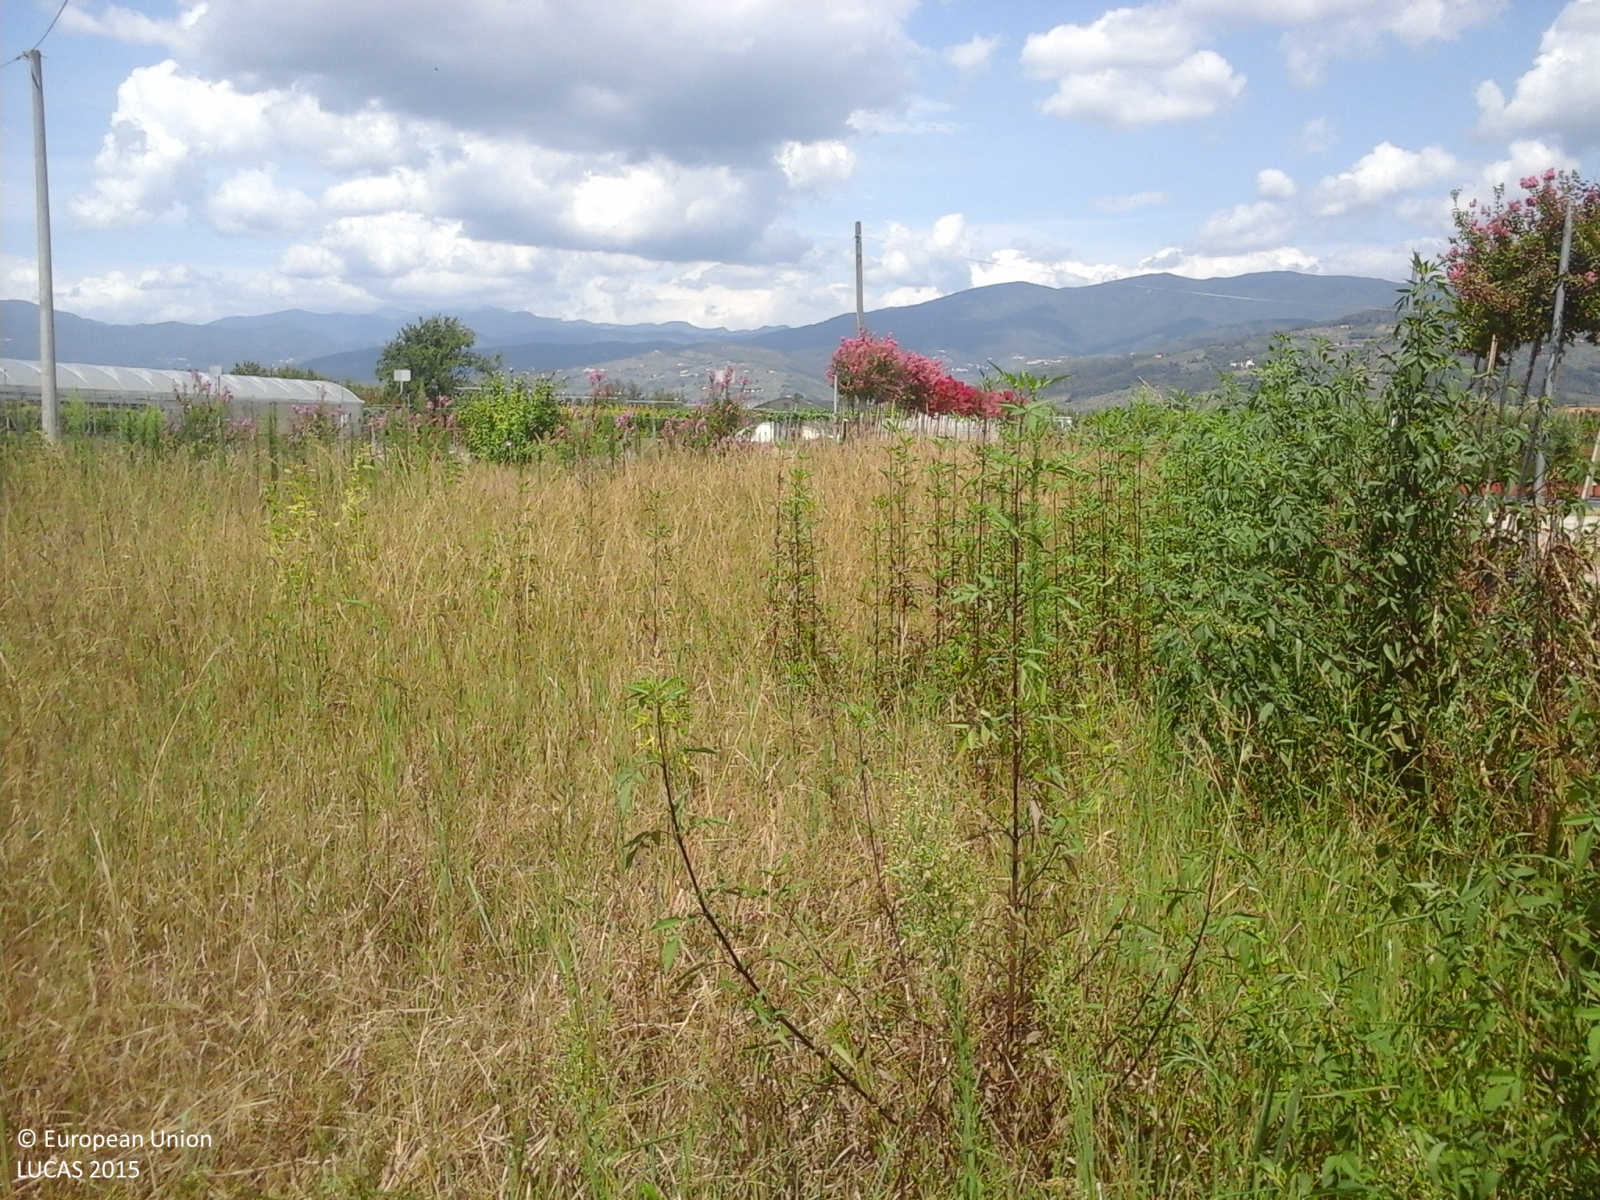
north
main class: Grassland
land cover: Spontaneously vegetated surfaces
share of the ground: > 75 %
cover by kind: herbaceous plants 95 %, shrubs 5 %
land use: Agriculture (excluding fallow land and kitchen gardens)
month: August
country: IT
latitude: 43.9132
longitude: 10.9564
